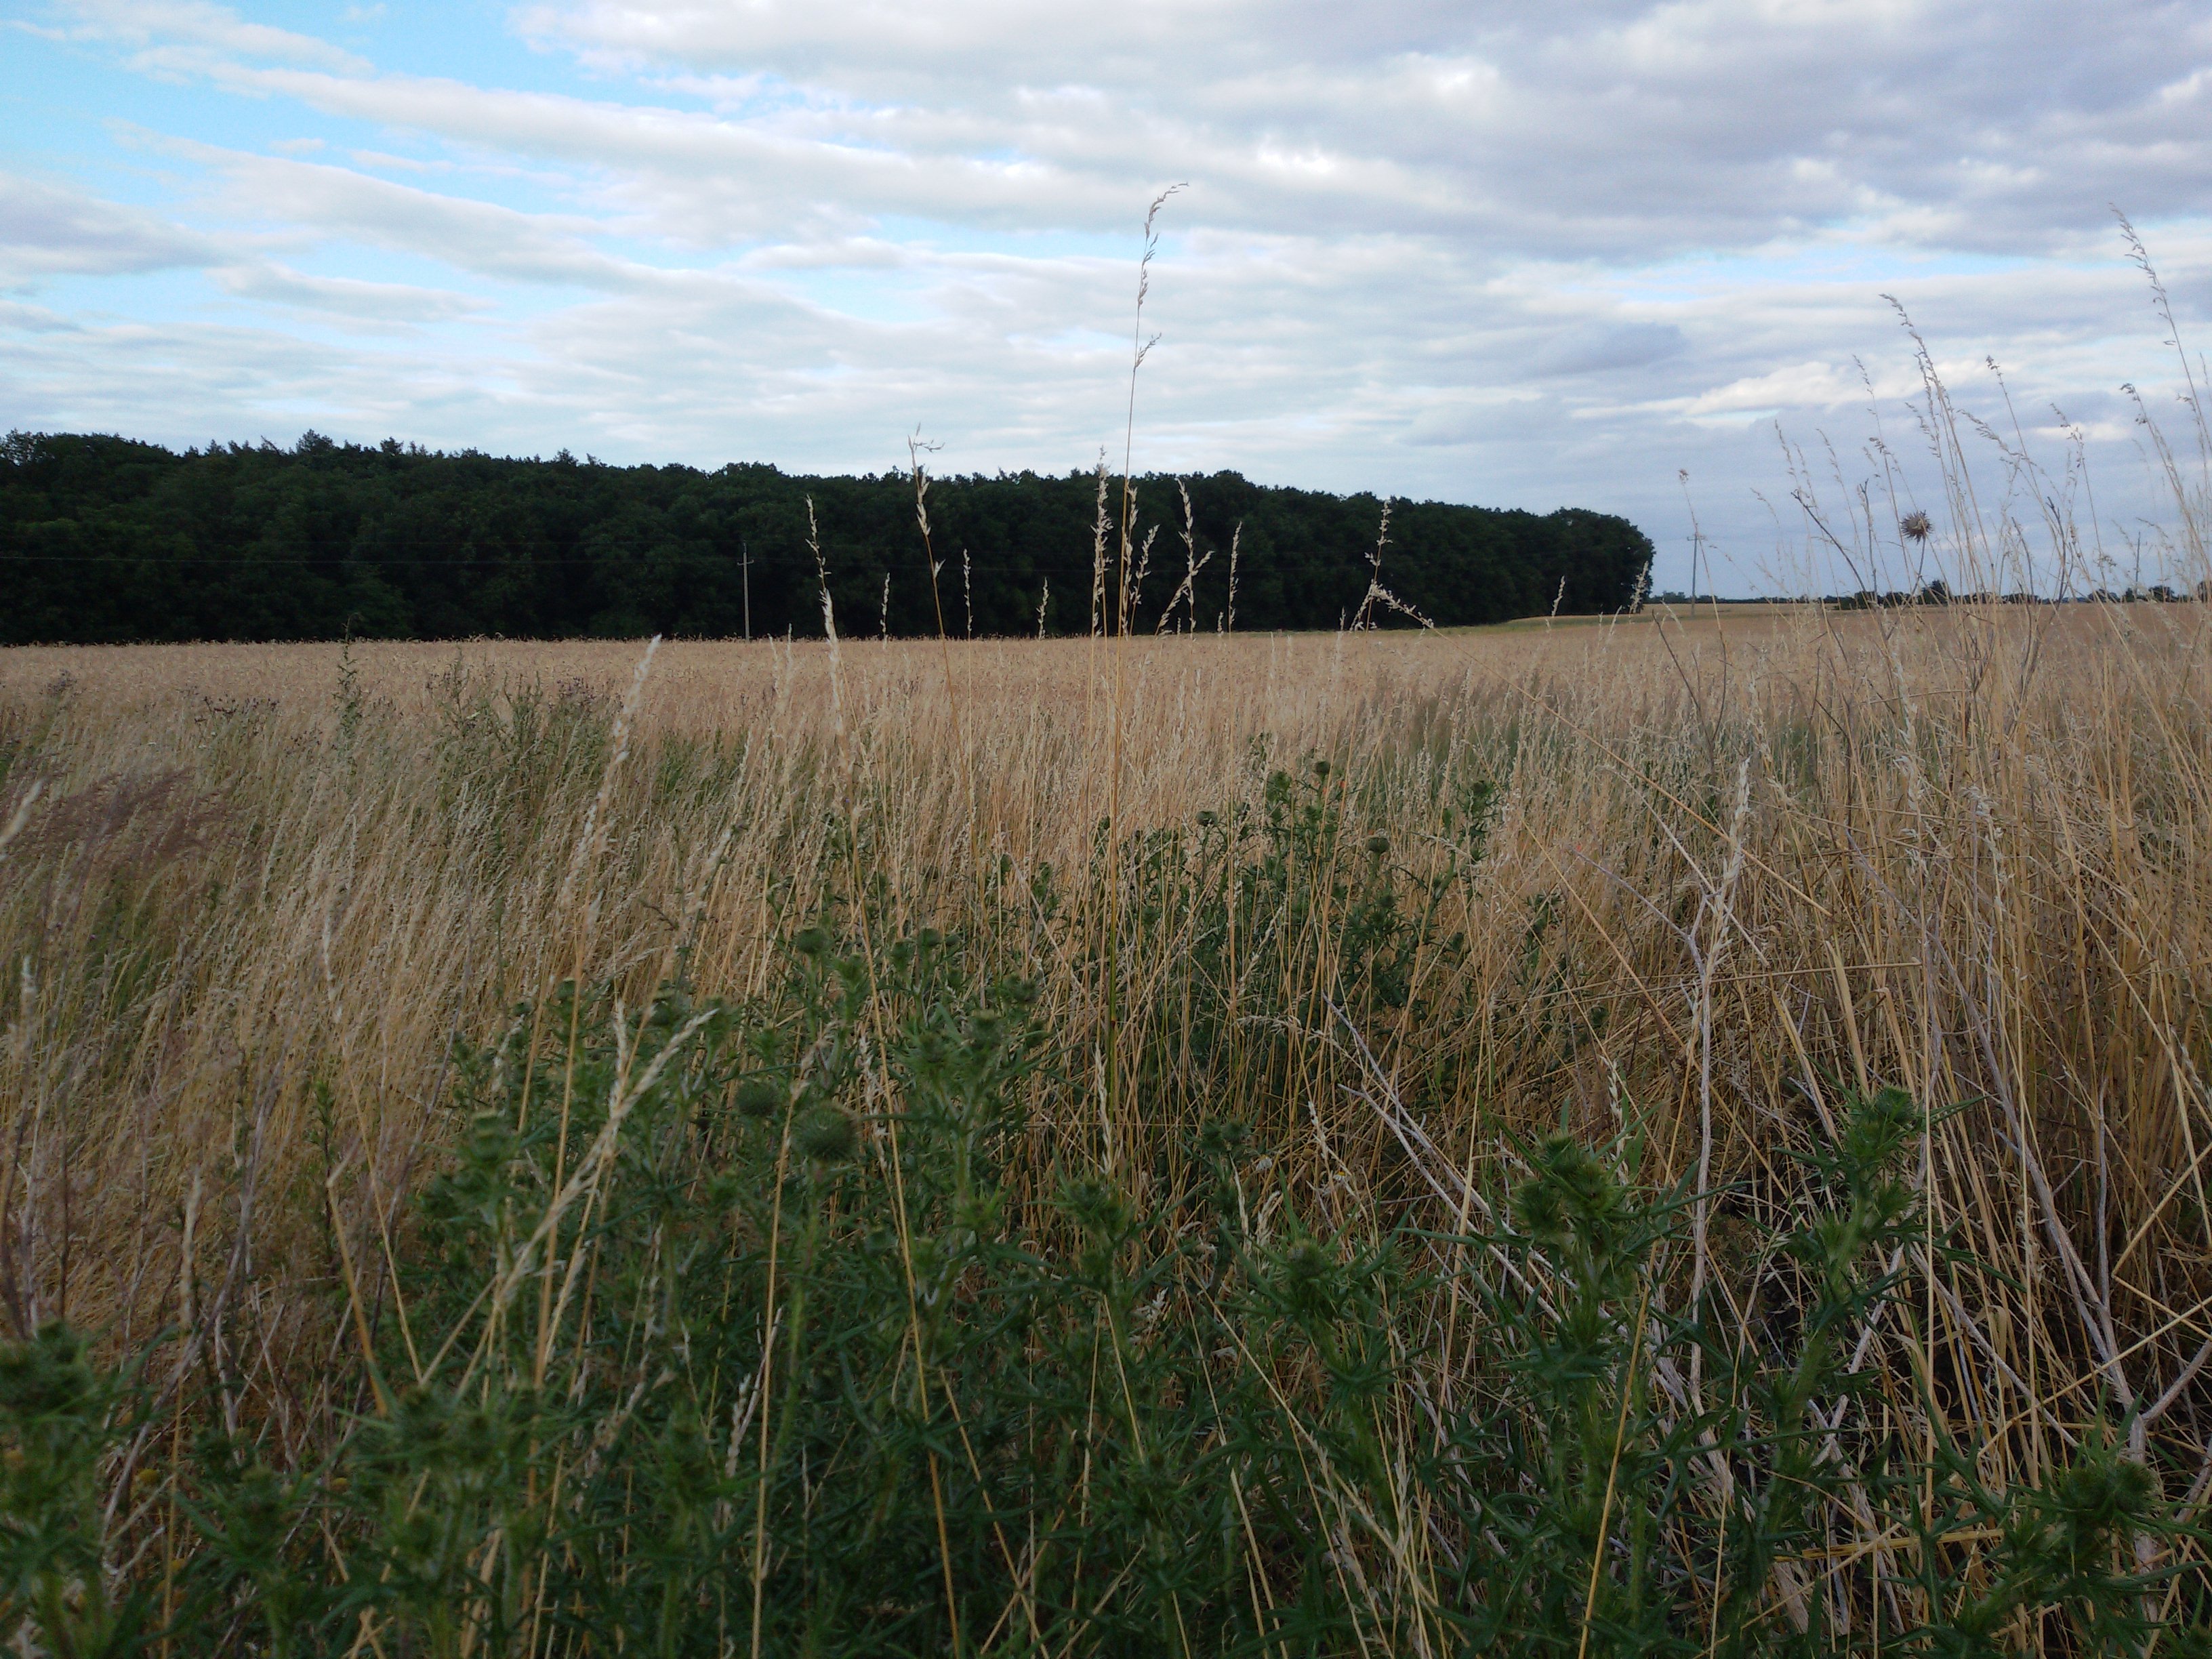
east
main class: Grassland
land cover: Spontaneously vegetated surfaces
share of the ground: > 75 %
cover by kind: herbaceous plants 100 %
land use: Logistics and storage
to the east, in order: Spontaneously vegetated surfaces; Tracks; Rye; Grass margins; Common wheat; Dry pulses; Electric lines; Dry pulses
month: June
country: PL
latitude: 51.8949
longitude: 17.0874
